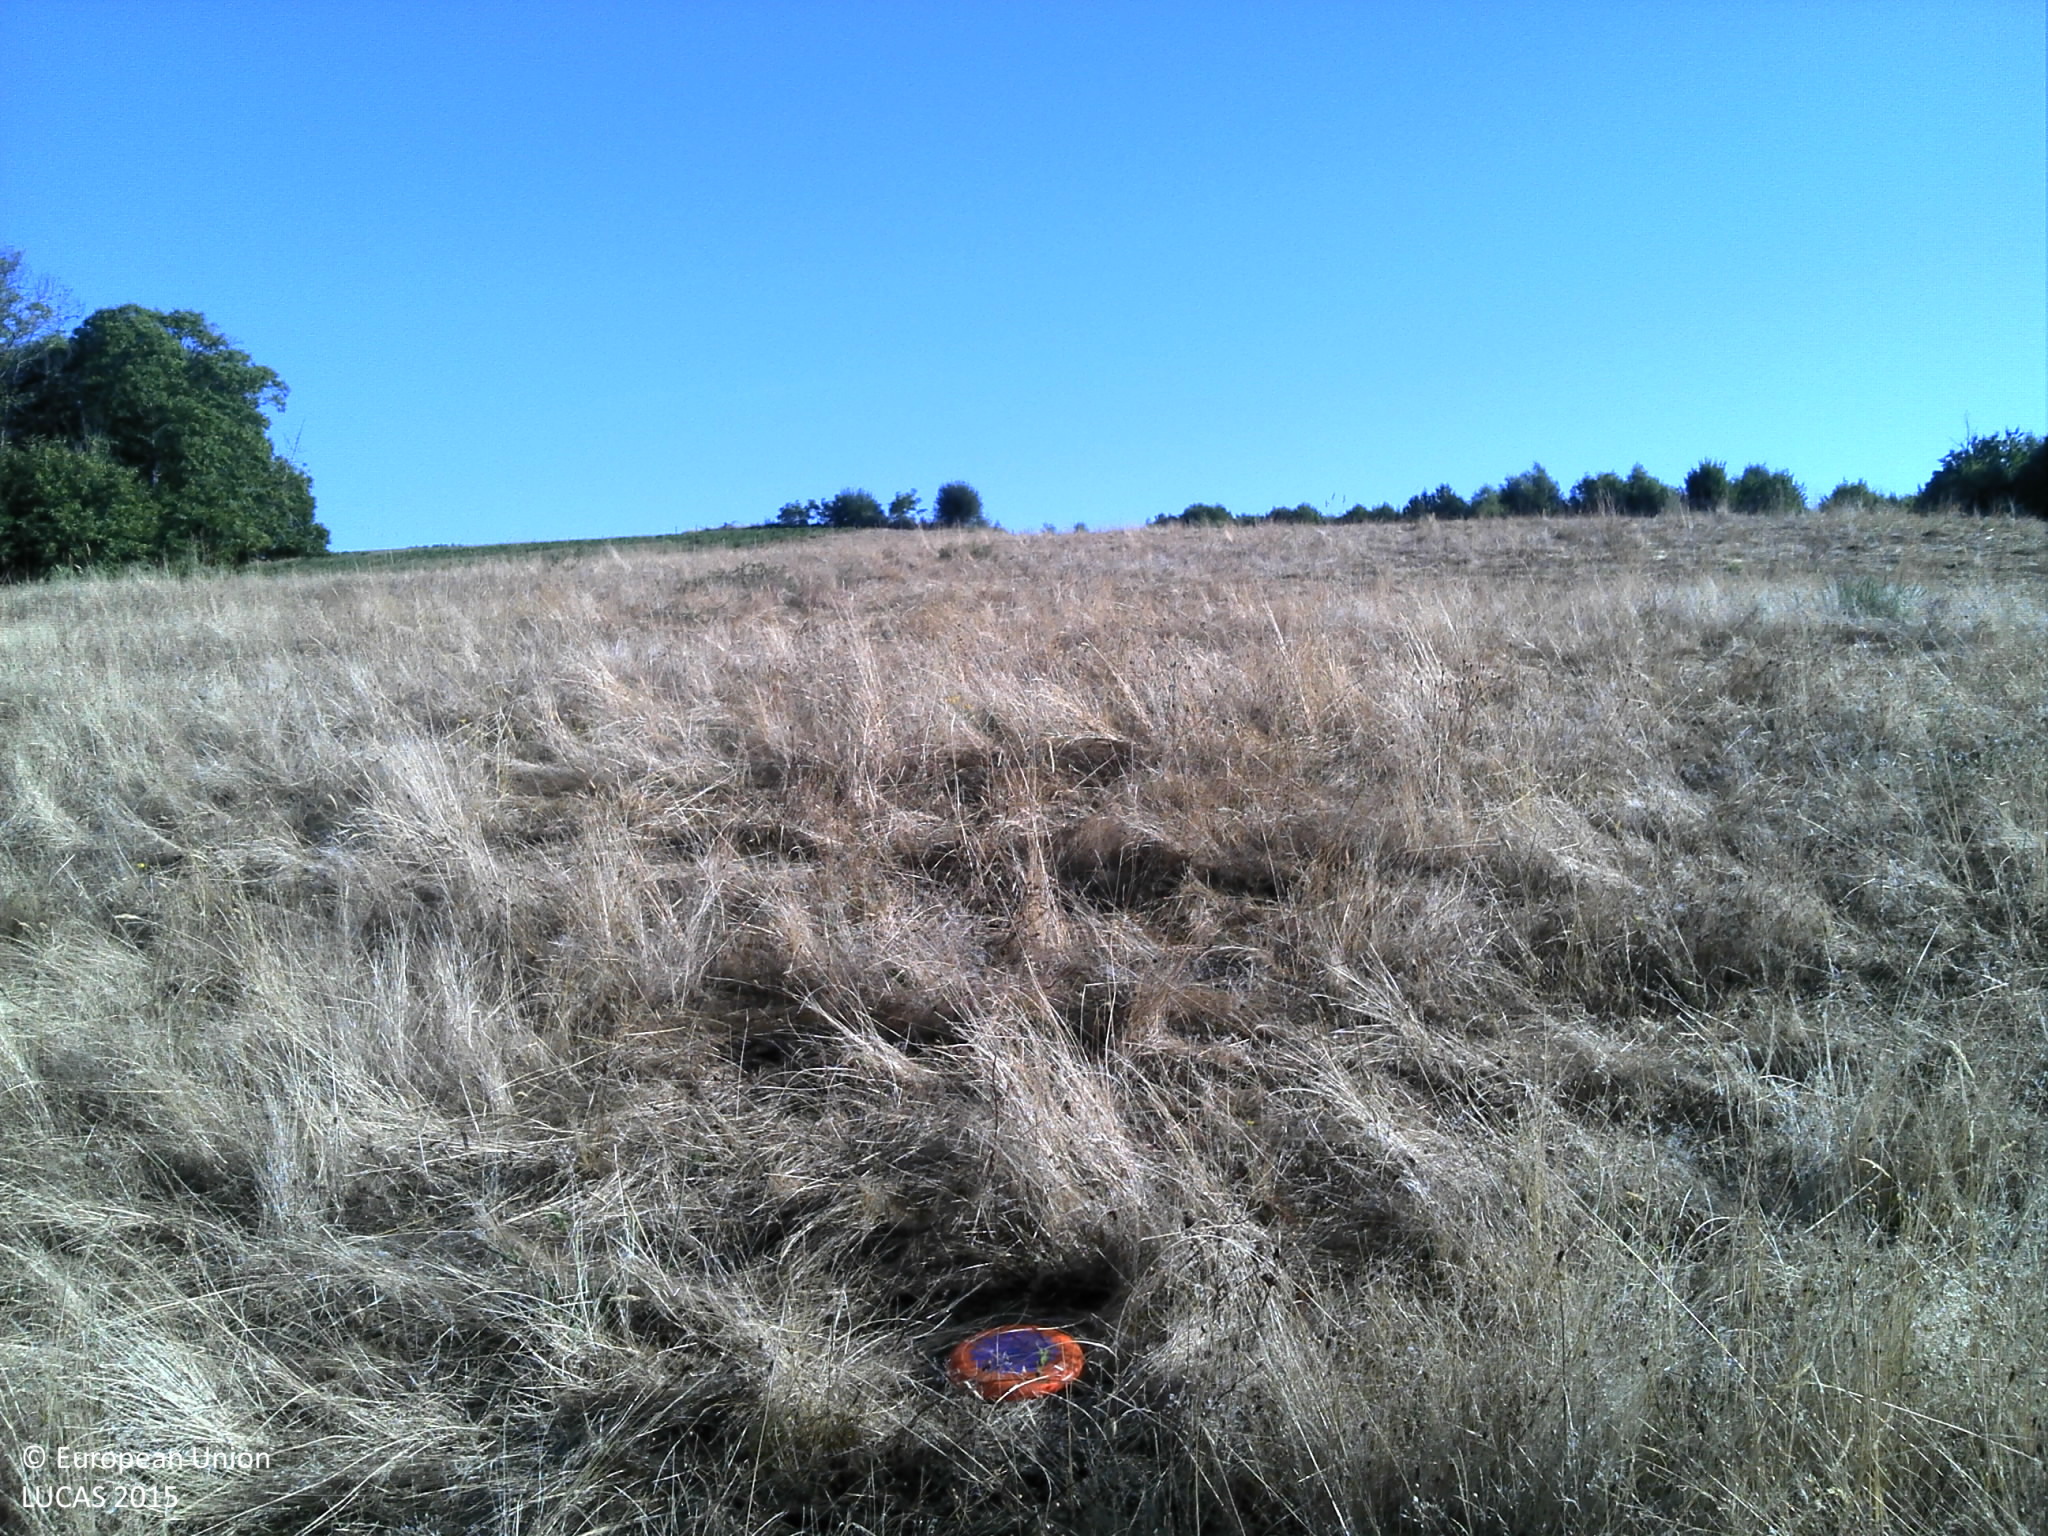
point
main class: Grassland
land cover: Grassland without tree/shrub cover
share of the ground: > 75 %
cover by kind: herbaceous plants 100 %
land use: Agriculture (excluding fallow land and kitchen gardens)
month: August
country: FR
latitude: 45.0806
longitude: 1.8542
